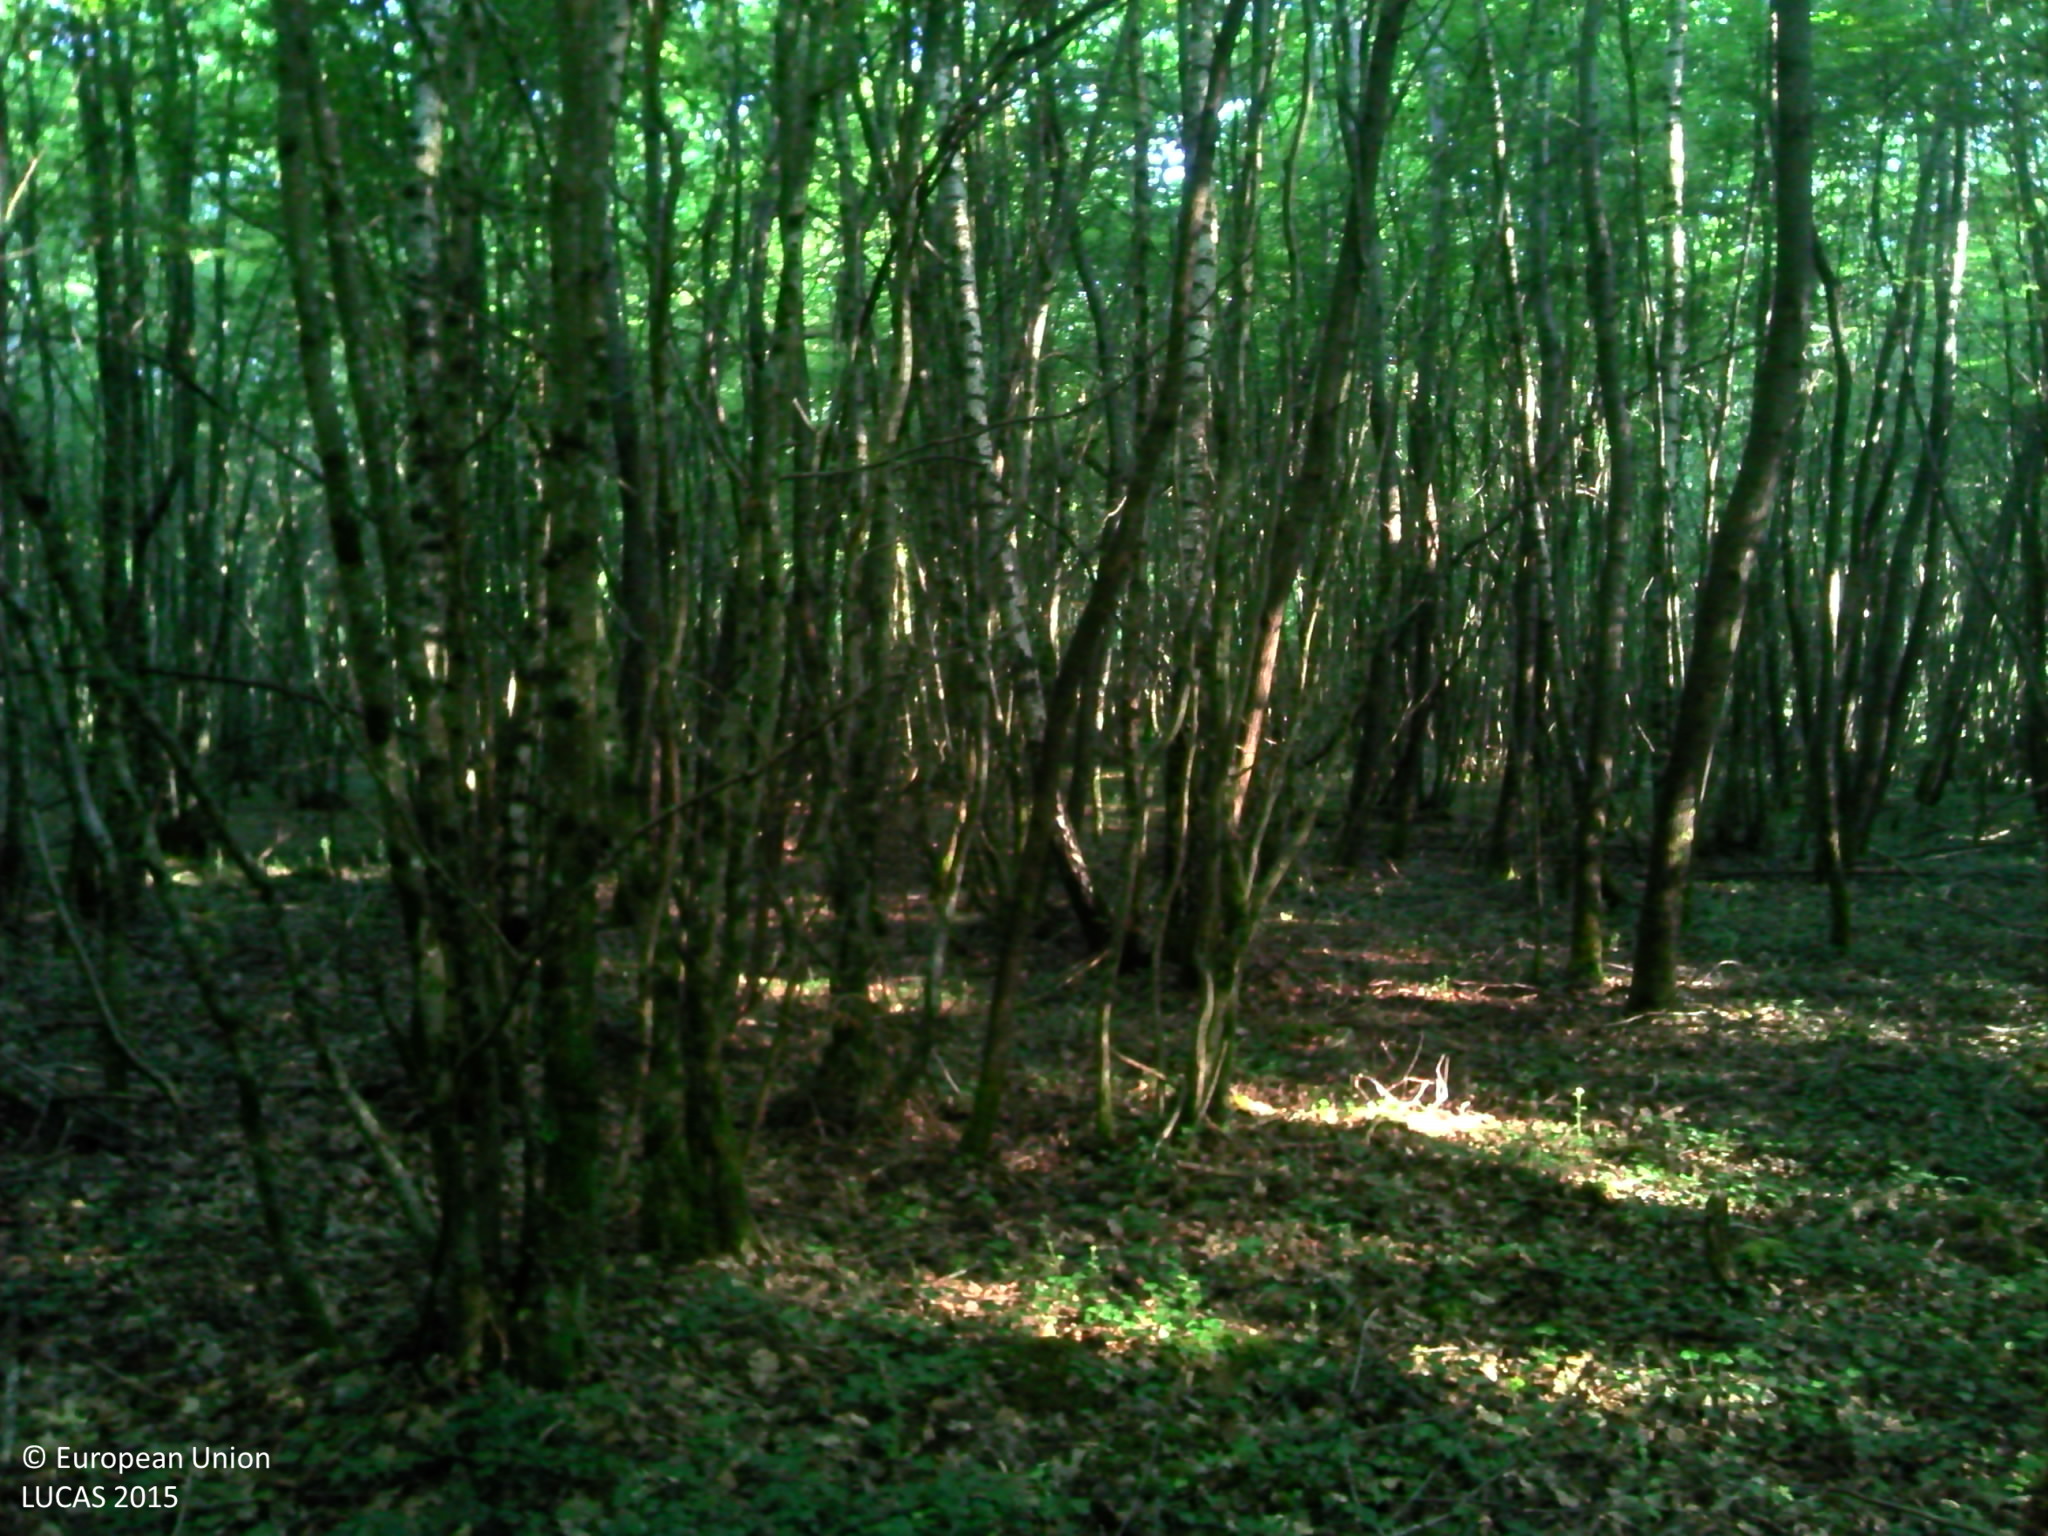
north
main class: Woodland
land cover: Broadleaved woodland
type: acidophilous oak and oak-birch forest
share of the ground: > 75 %
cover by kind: broadleaved forest trees 95 %, herbaceous plants 5 %
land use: Forestry
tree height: > 5 m
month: June
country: FR
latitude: 46.7026
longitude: 5.3853
